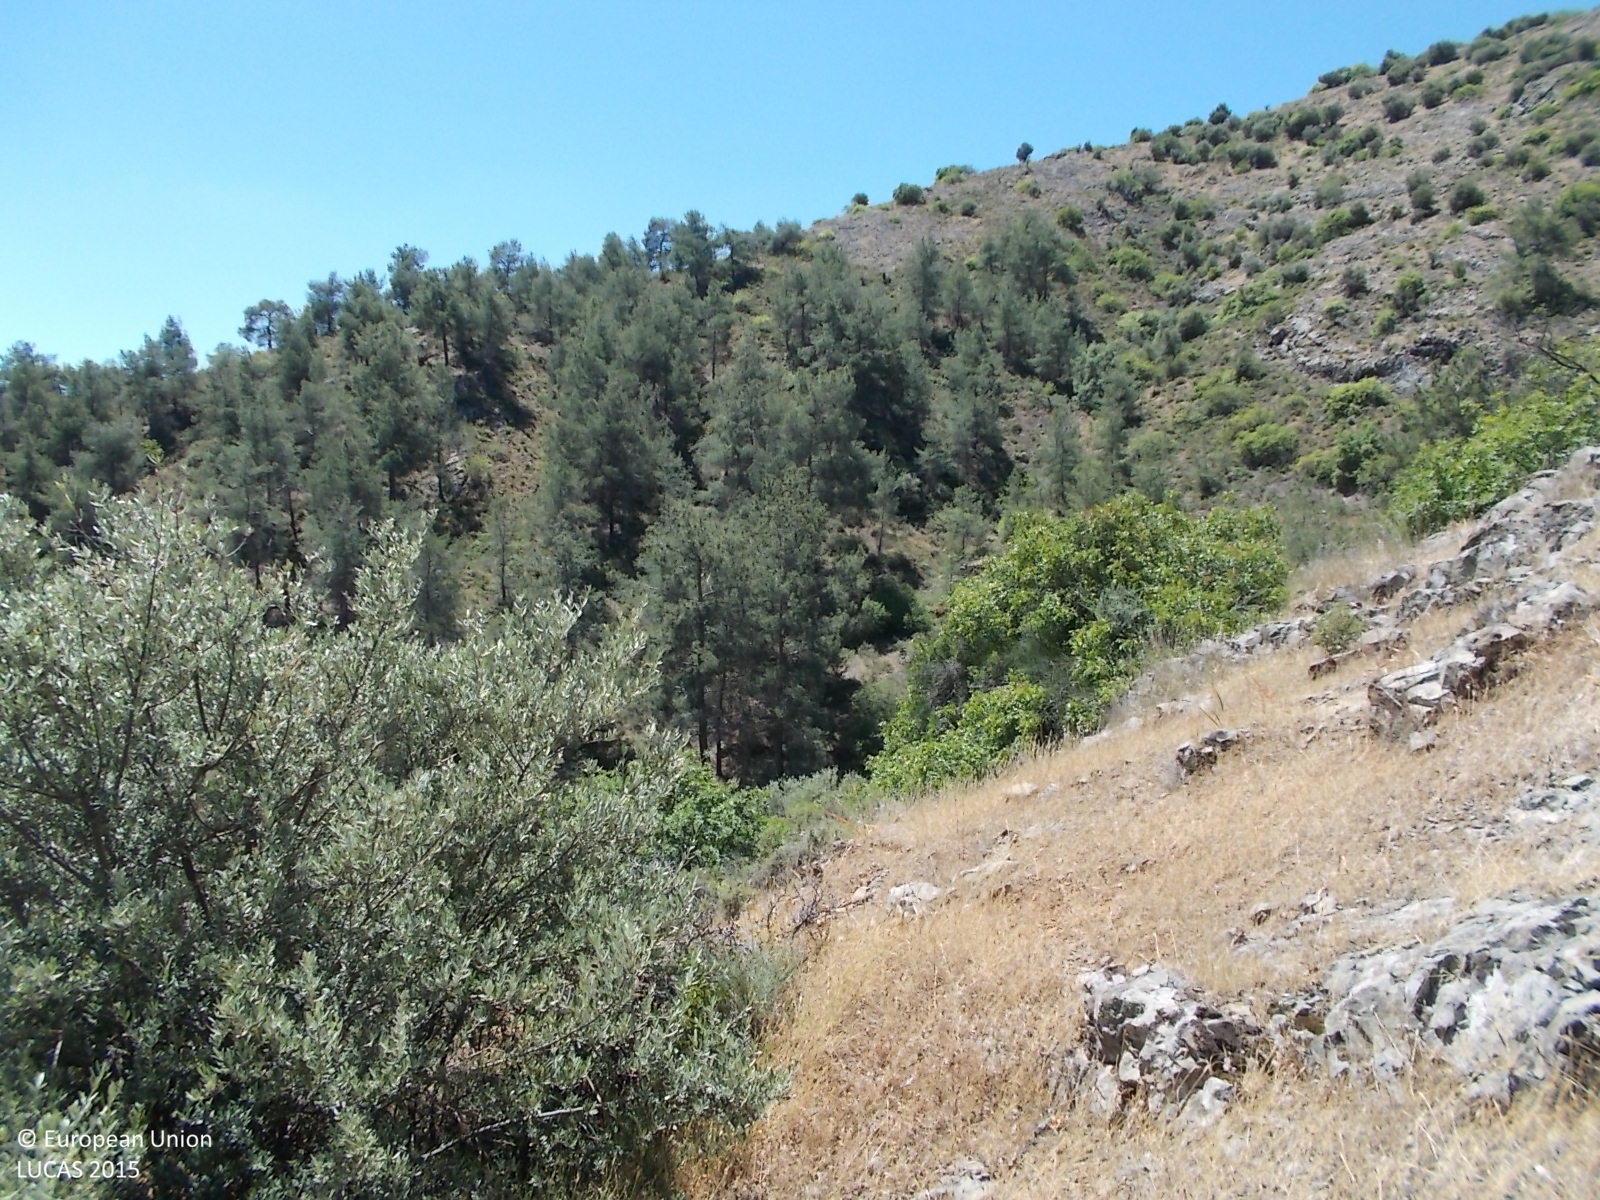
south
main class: Shrubland
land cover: Shrubland with sparse tree cover
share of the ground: > 75 %
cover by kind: shrubs 95 %, broadleaved forest trees 5 %
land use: Semi-natural and natural areas not in use
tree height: < 5 m
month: May
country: CY
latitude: 34.9687
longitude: 33.1233
